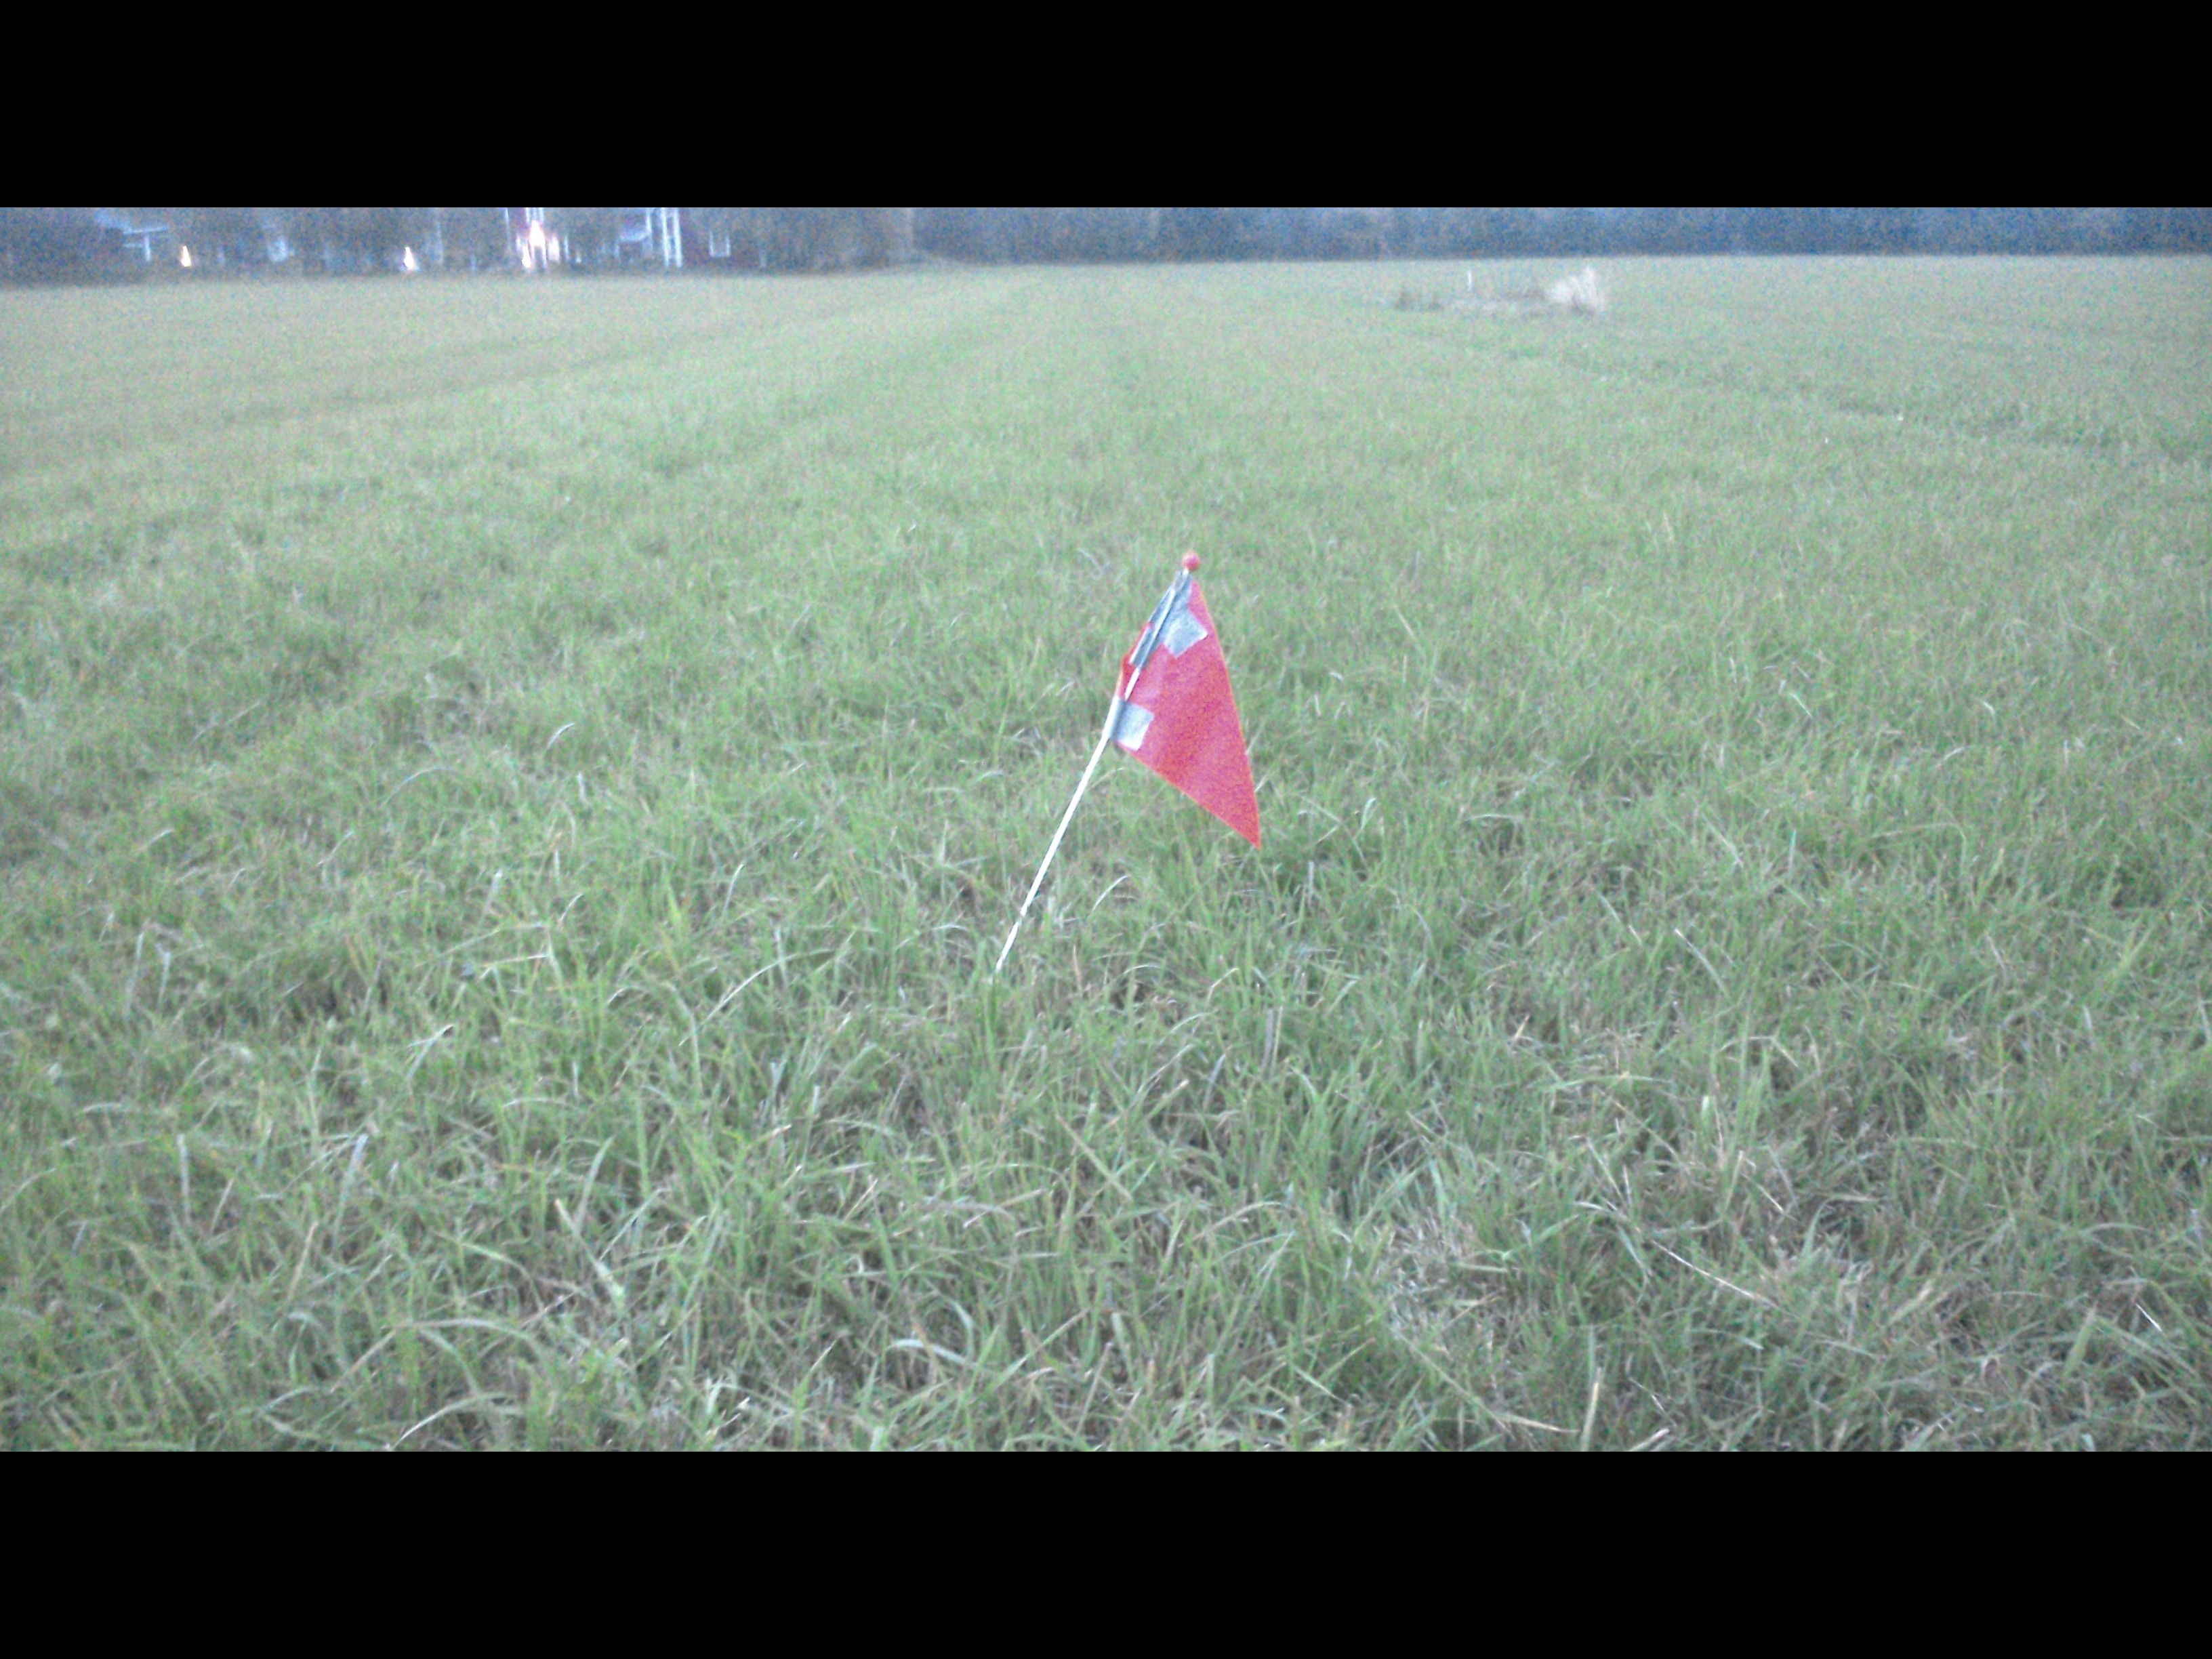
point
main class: Grassland
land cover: Grassland without tree/shrub cover
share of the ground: > 75 %
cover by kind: herbaceous plants 100 %
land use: Agriculture (excluding fallow land and kitchen gardens)
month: September
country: SE
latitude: 63.9084
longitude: 19.8625
